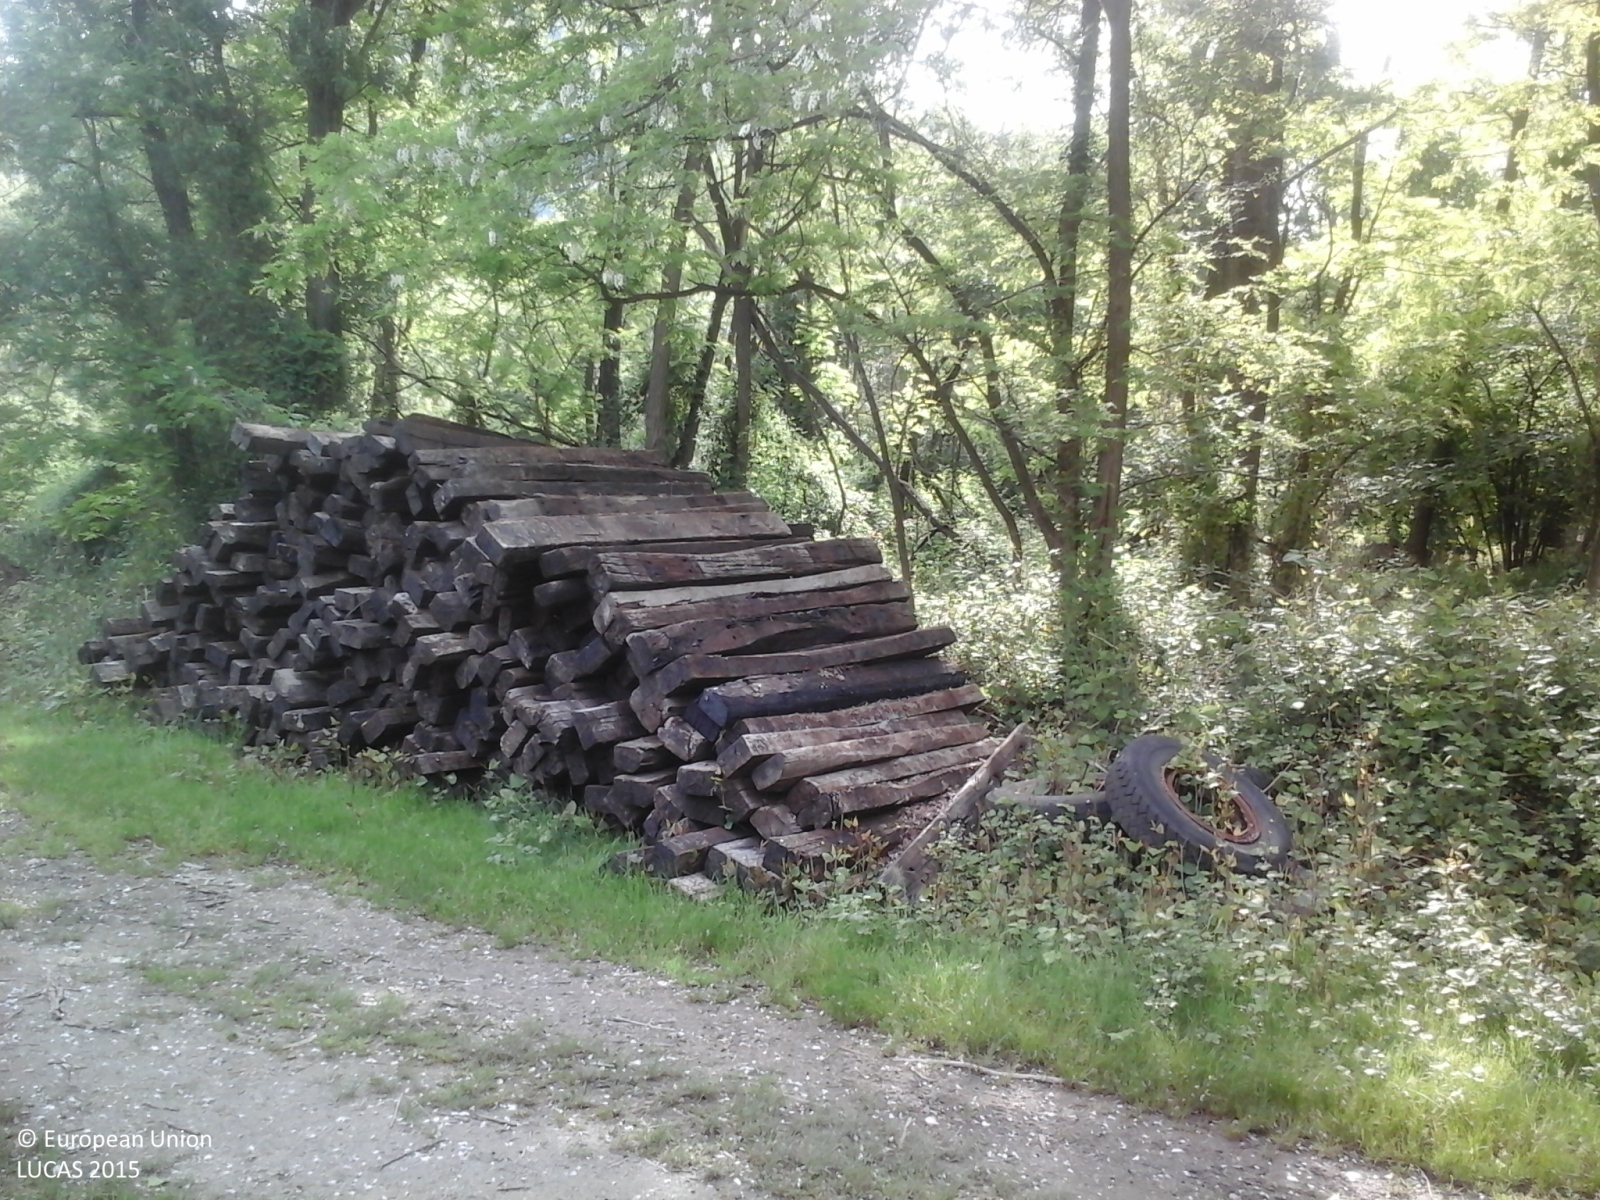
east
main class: Woodland
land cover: Broadleaved woodland
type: non-riverine alder, birch or aspen forest
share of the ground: > 75 %
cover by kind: broadleaved forest trees 100 %
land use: Forestry
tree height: < 5 m
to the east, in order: Broadleaved woodland; Tracks; Broadleaved woodland; Tracks; Broadleaved woodland
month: May
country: IT
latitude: 45.7069
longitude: 8.2943
